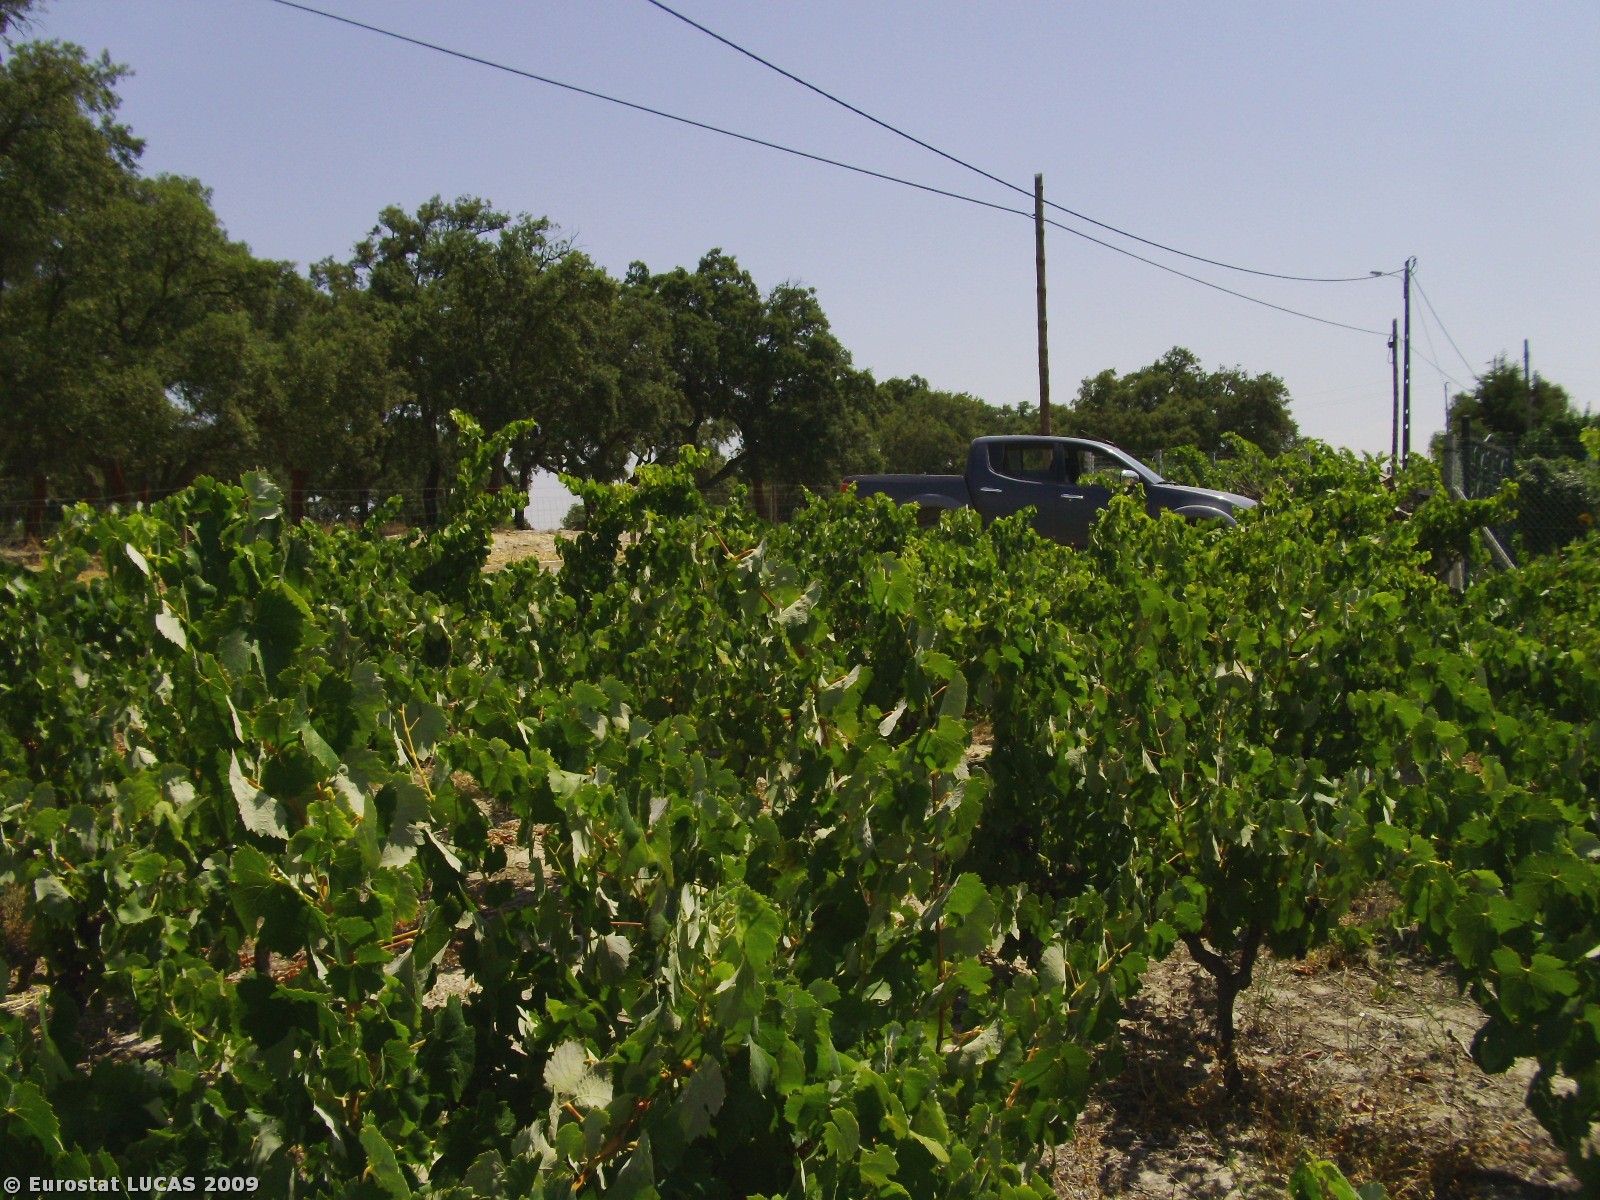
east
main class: Cropland
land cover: Vineyards
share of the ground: 25 - 50 %
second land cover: Spontaneously vegetated surfaces
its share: 50 - 75 %
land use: Agriculture (excluding fallow land and kitchen gardens)
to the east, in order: Vineyards; Spontaneously vegetated surfaces; Vineyards; Tracks; Vineyards; Electric lines; Other structural elements; Paved roads, cycling and walking lanes; Fences; Broadleaved woodland; Fences; Broadleaved woodland; Tracks; Broadleaved woodland
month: July
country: PT
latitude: 38.5735
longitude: -8.8301
